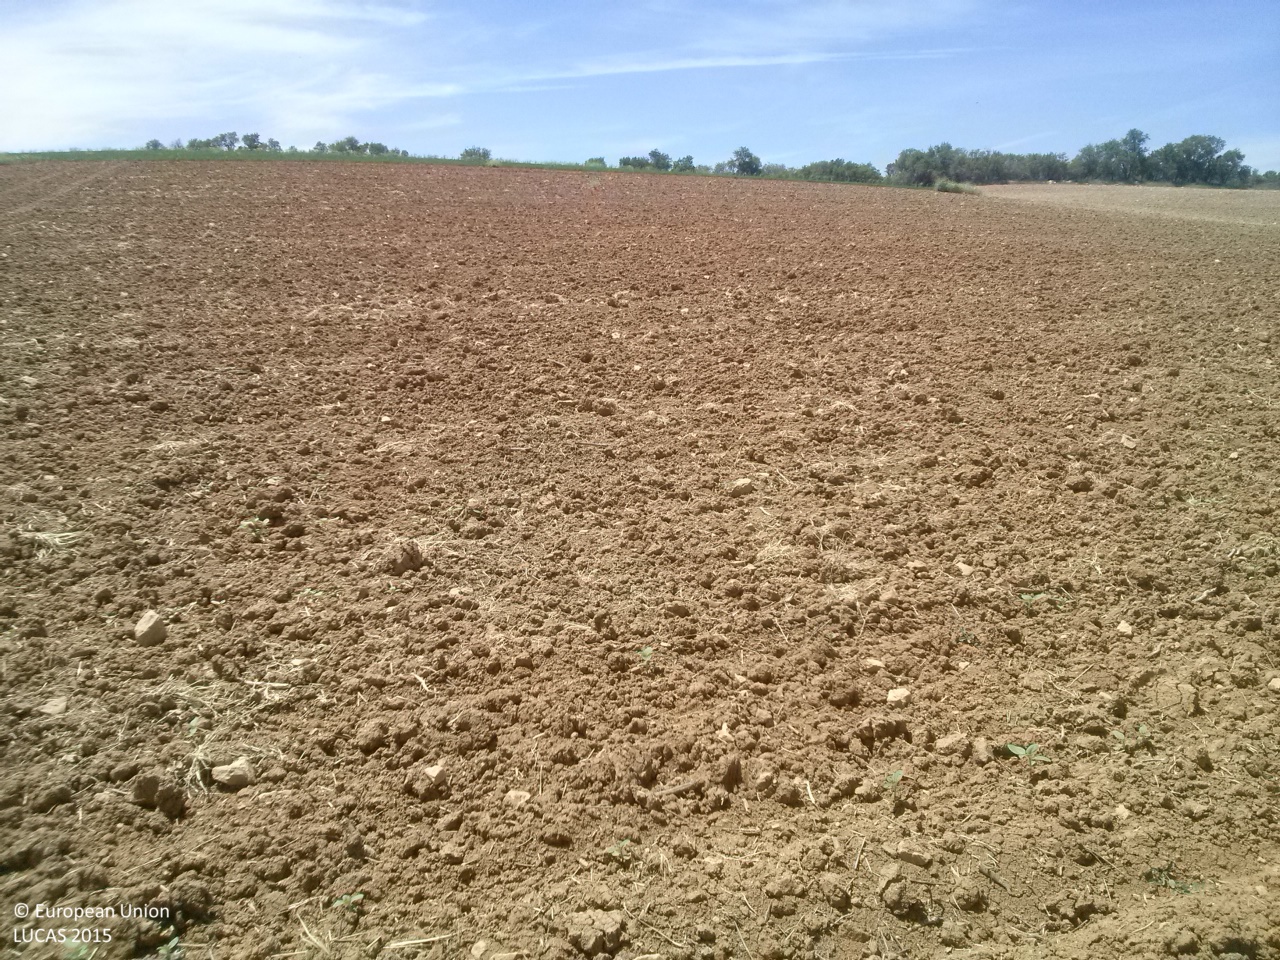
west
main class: Cropland
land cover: Sunflower
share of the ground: < 10 %
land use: Agriculture (excluding fallow land and kitchen gardens)
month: May
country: ES
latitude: 40.0223
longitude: -2.7104
